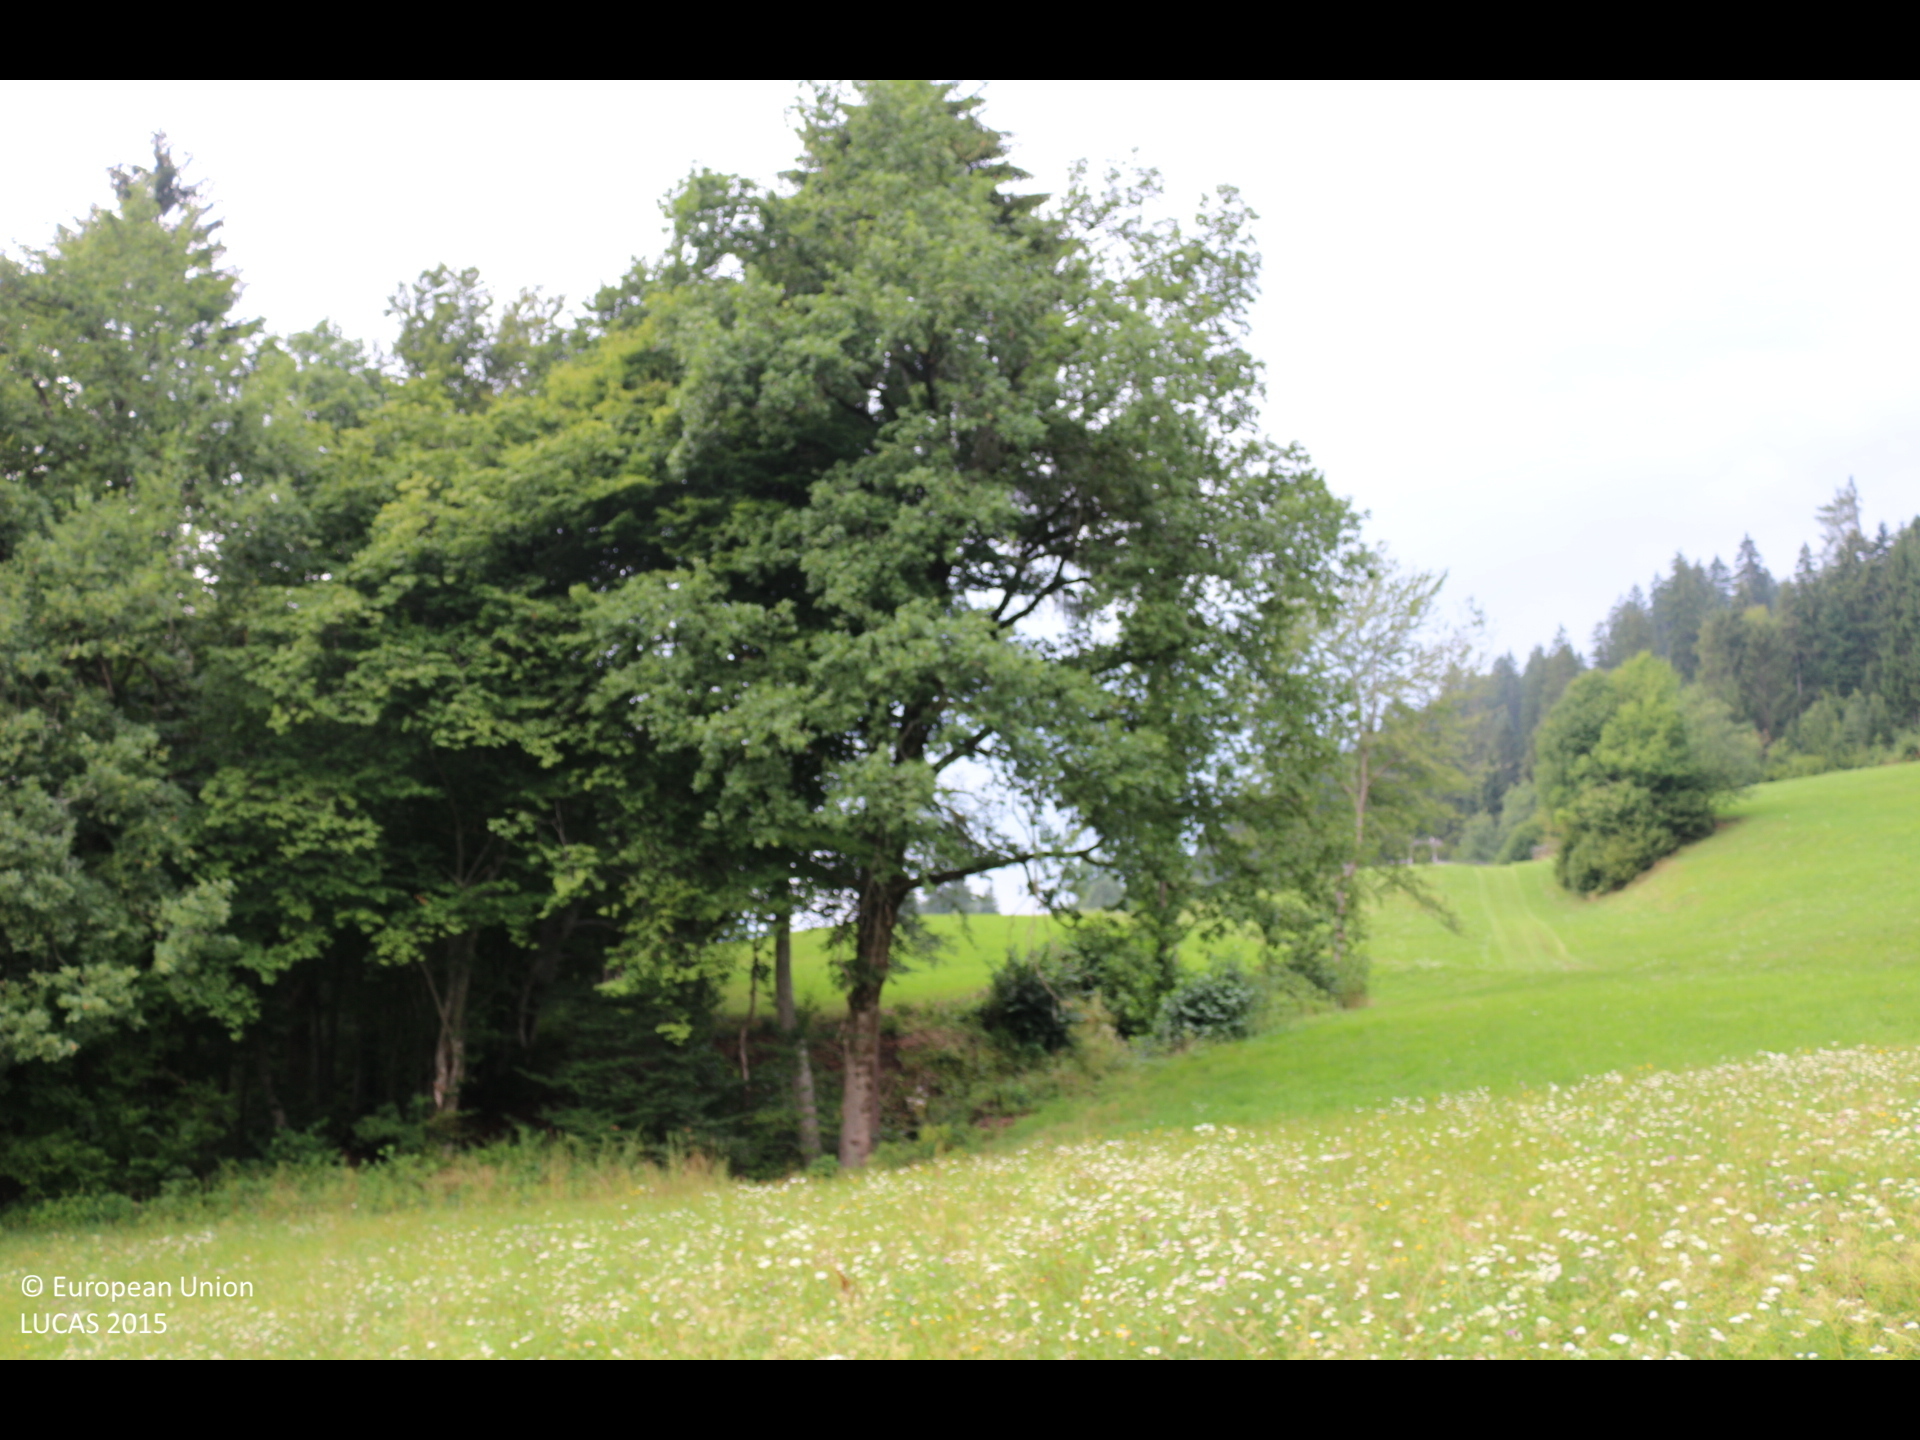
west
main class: Grassland
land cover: Grassland without tree/shrub cover
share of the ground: > 75 %
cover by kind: herbaceous plants 100 %
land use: Agriculture (excluding fallow land and kitchen gardens)
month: August
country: AT
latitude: 46.6247
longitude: 13.3014
